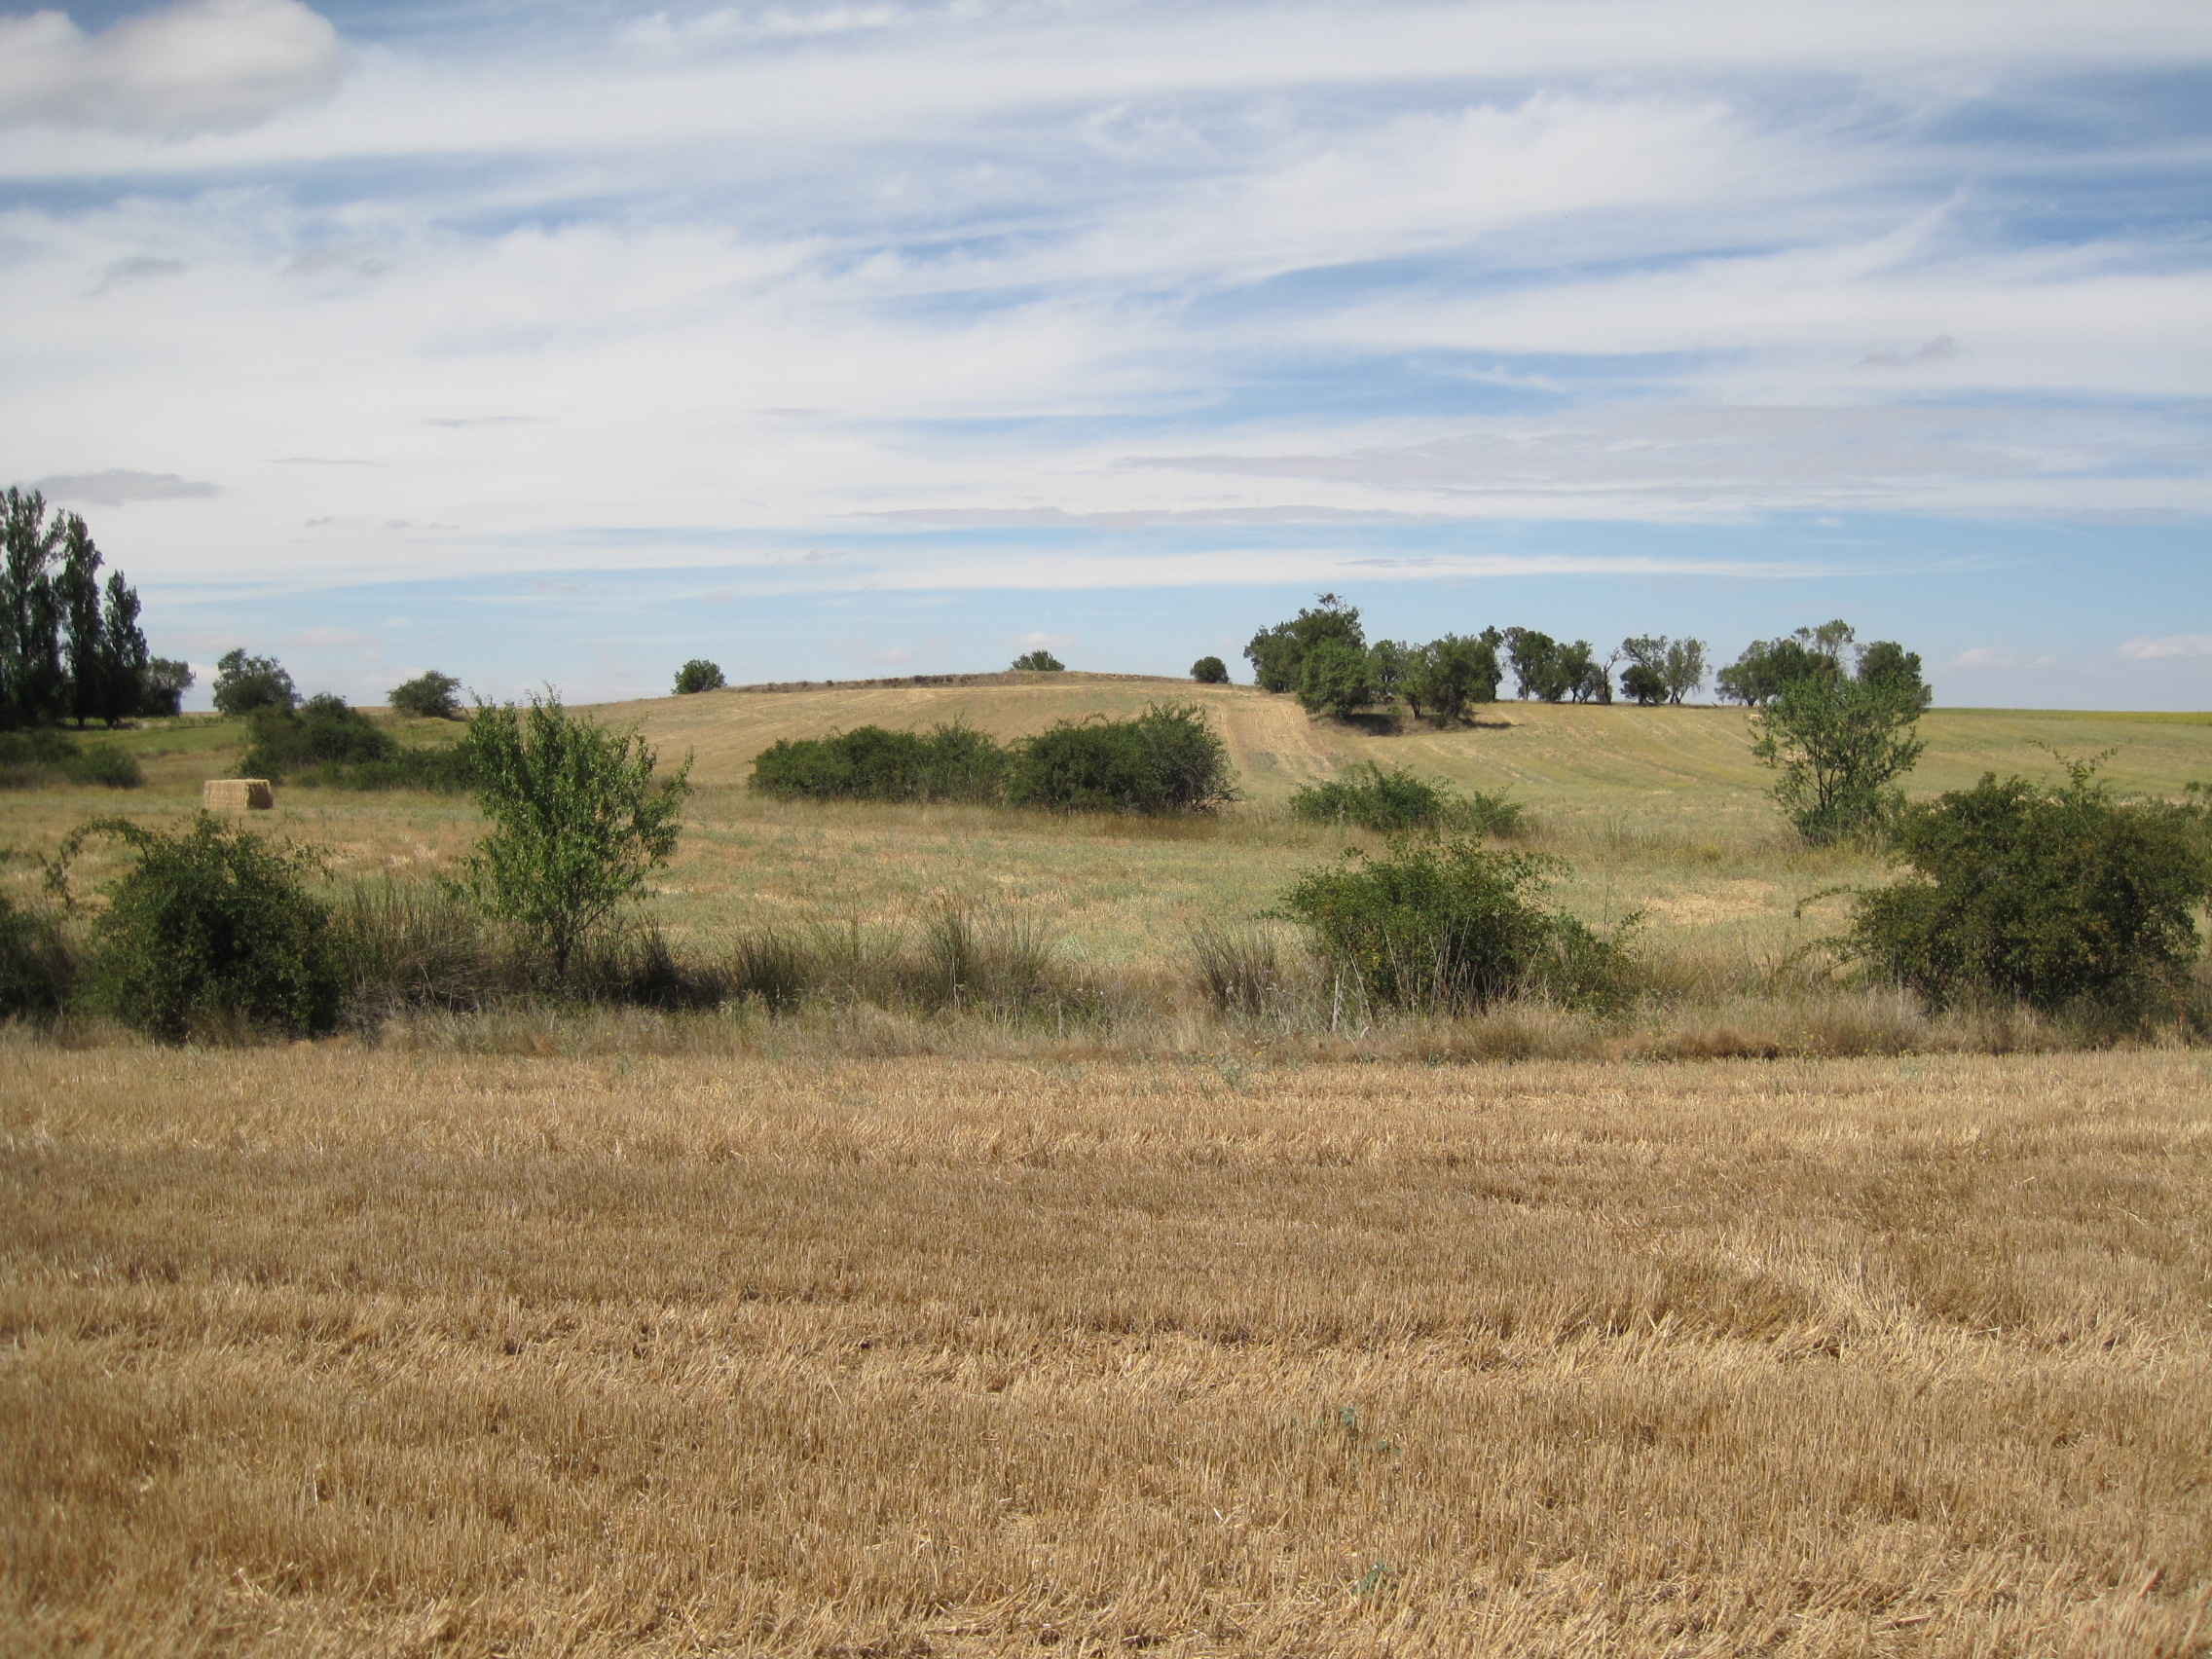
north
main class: Cropland
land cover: Barley
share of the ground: < 10 %
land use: Agriculture (excluding fallow land and kitchen gardens)
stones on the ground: < 10 %
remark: Harvested field
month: July
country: ES
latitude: 41.9932
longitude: -5.2079
